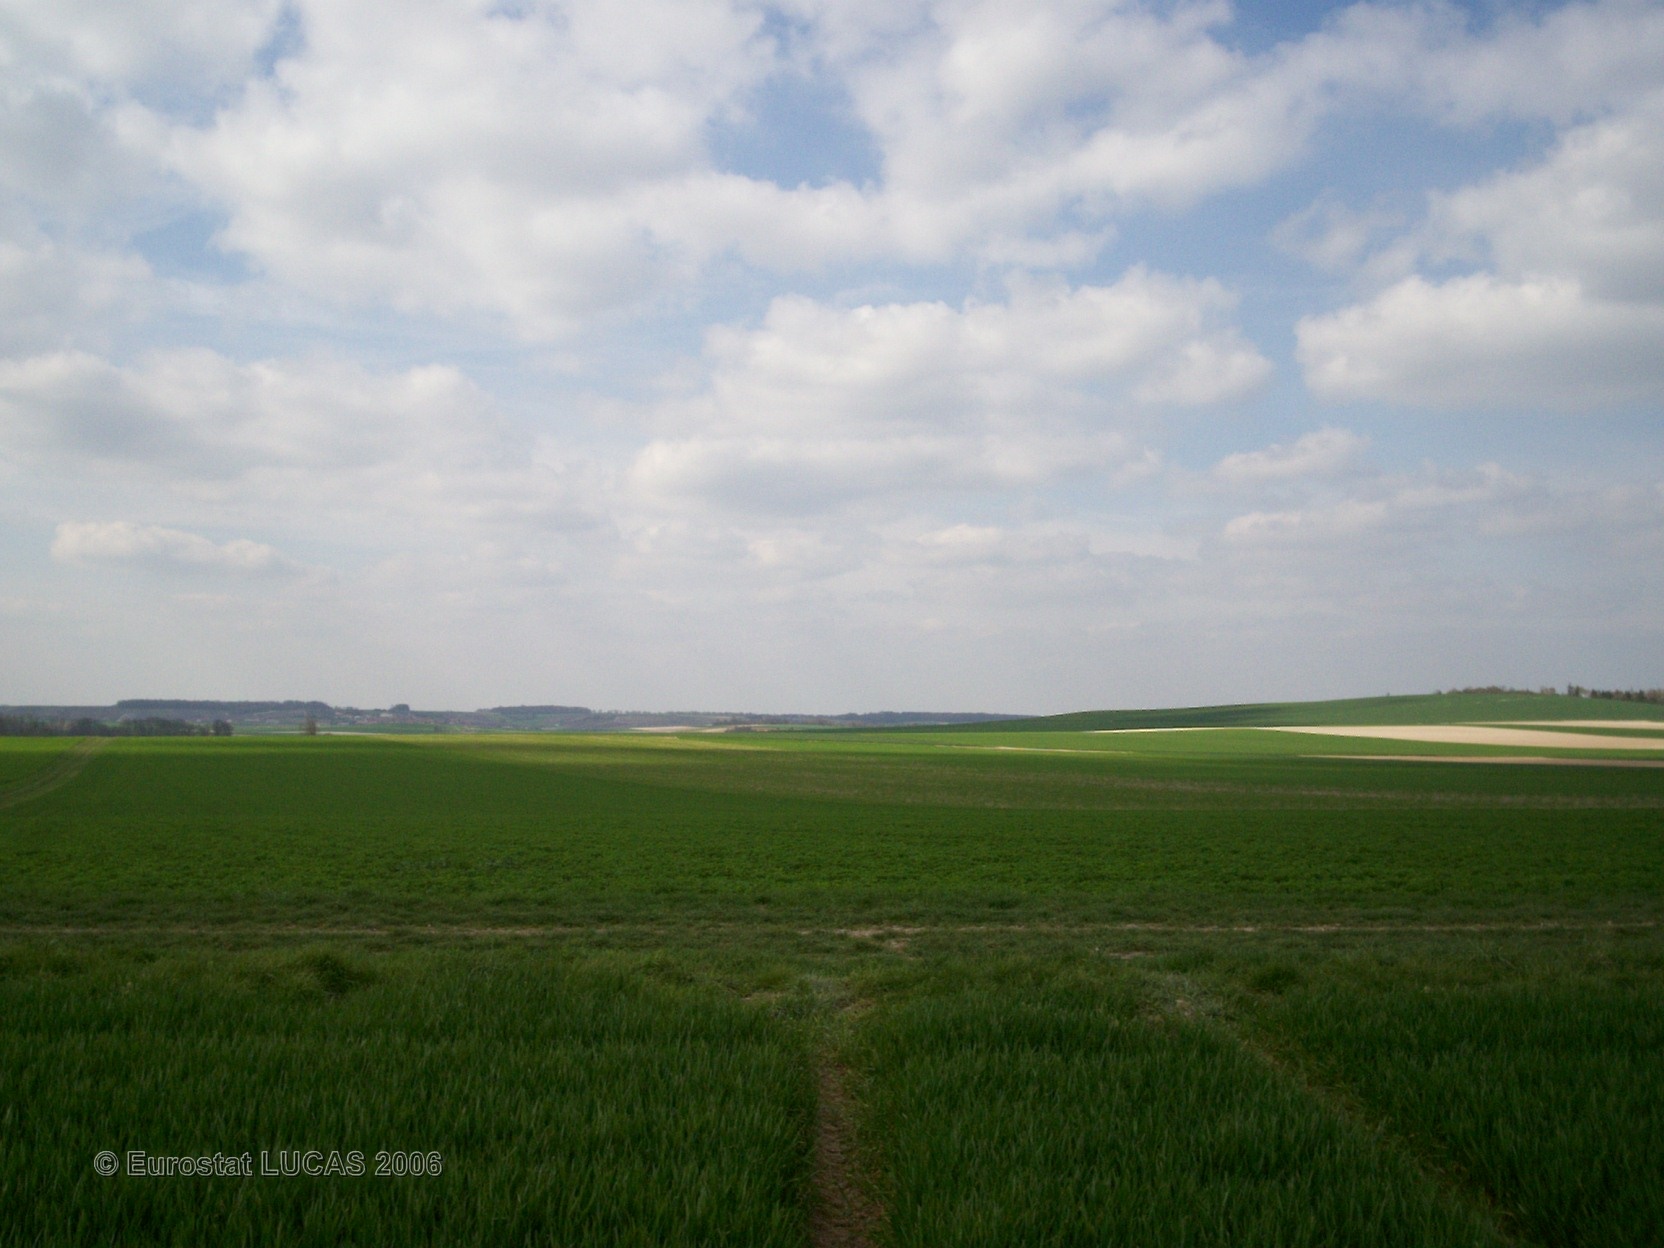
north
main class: Cropland
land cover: Common wheat
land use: Agriculture (excluding fallow land and kitchen gardens)
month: April
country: FR
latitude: 48.8502
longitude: 3.9306
